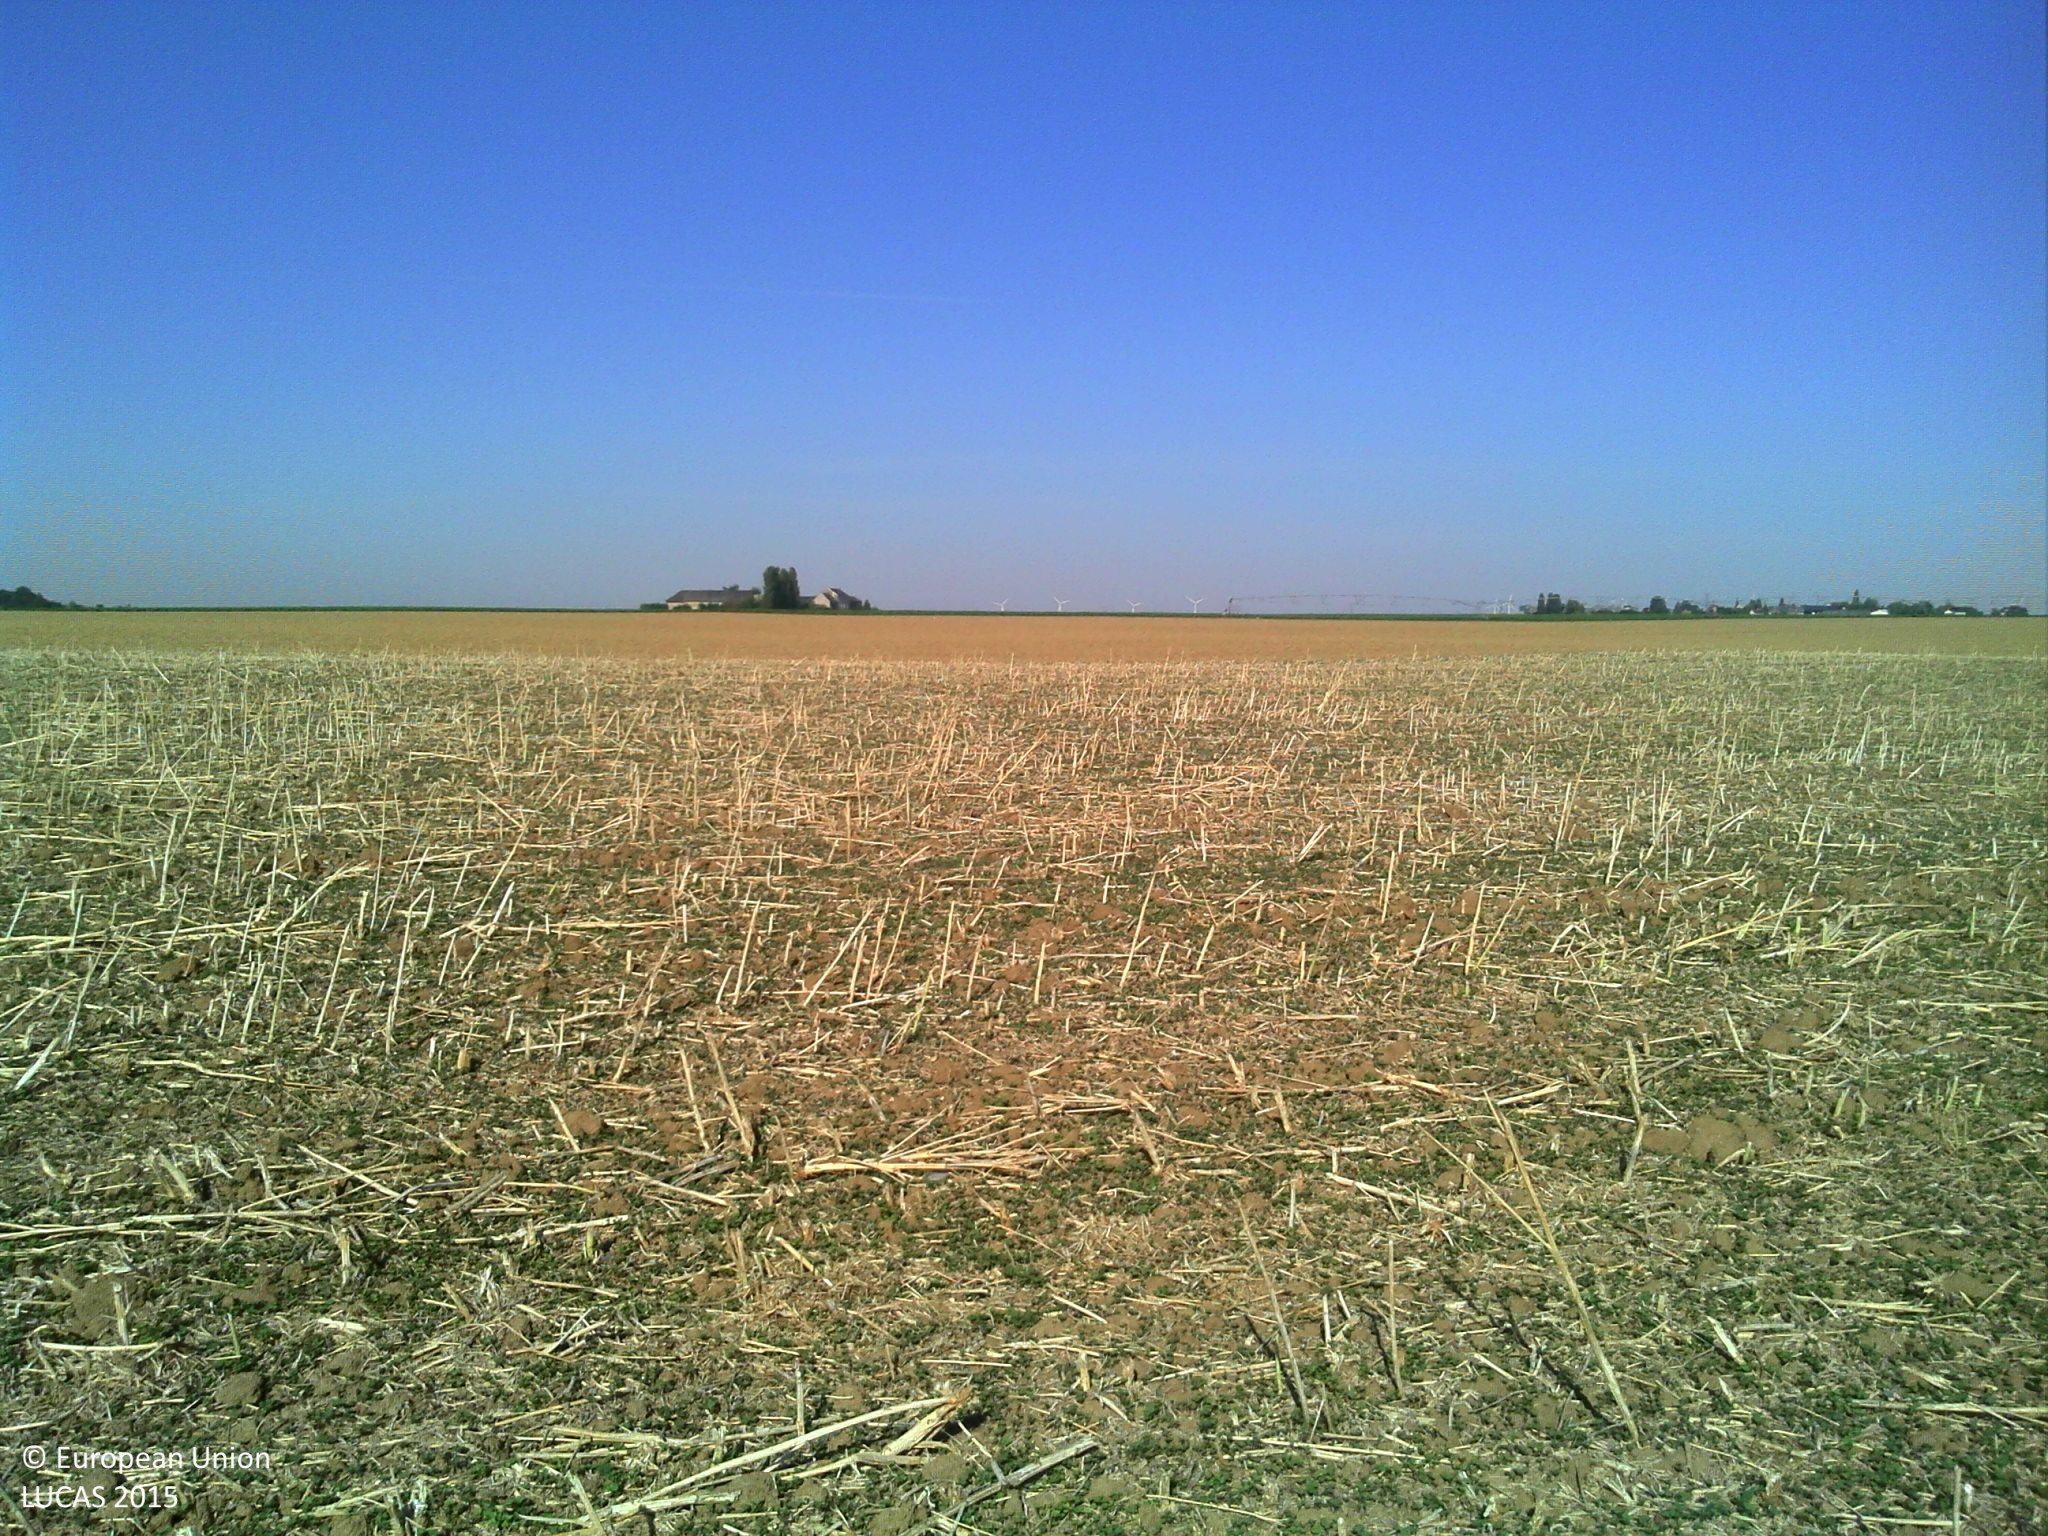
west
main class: Cropland
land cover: Rape and turnip rape
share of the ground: 10 - 25 %
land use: Agriculture (excluding fallow land and kitchen gardens)
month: August
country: FR
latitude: 48.1309
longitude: 1.9926
